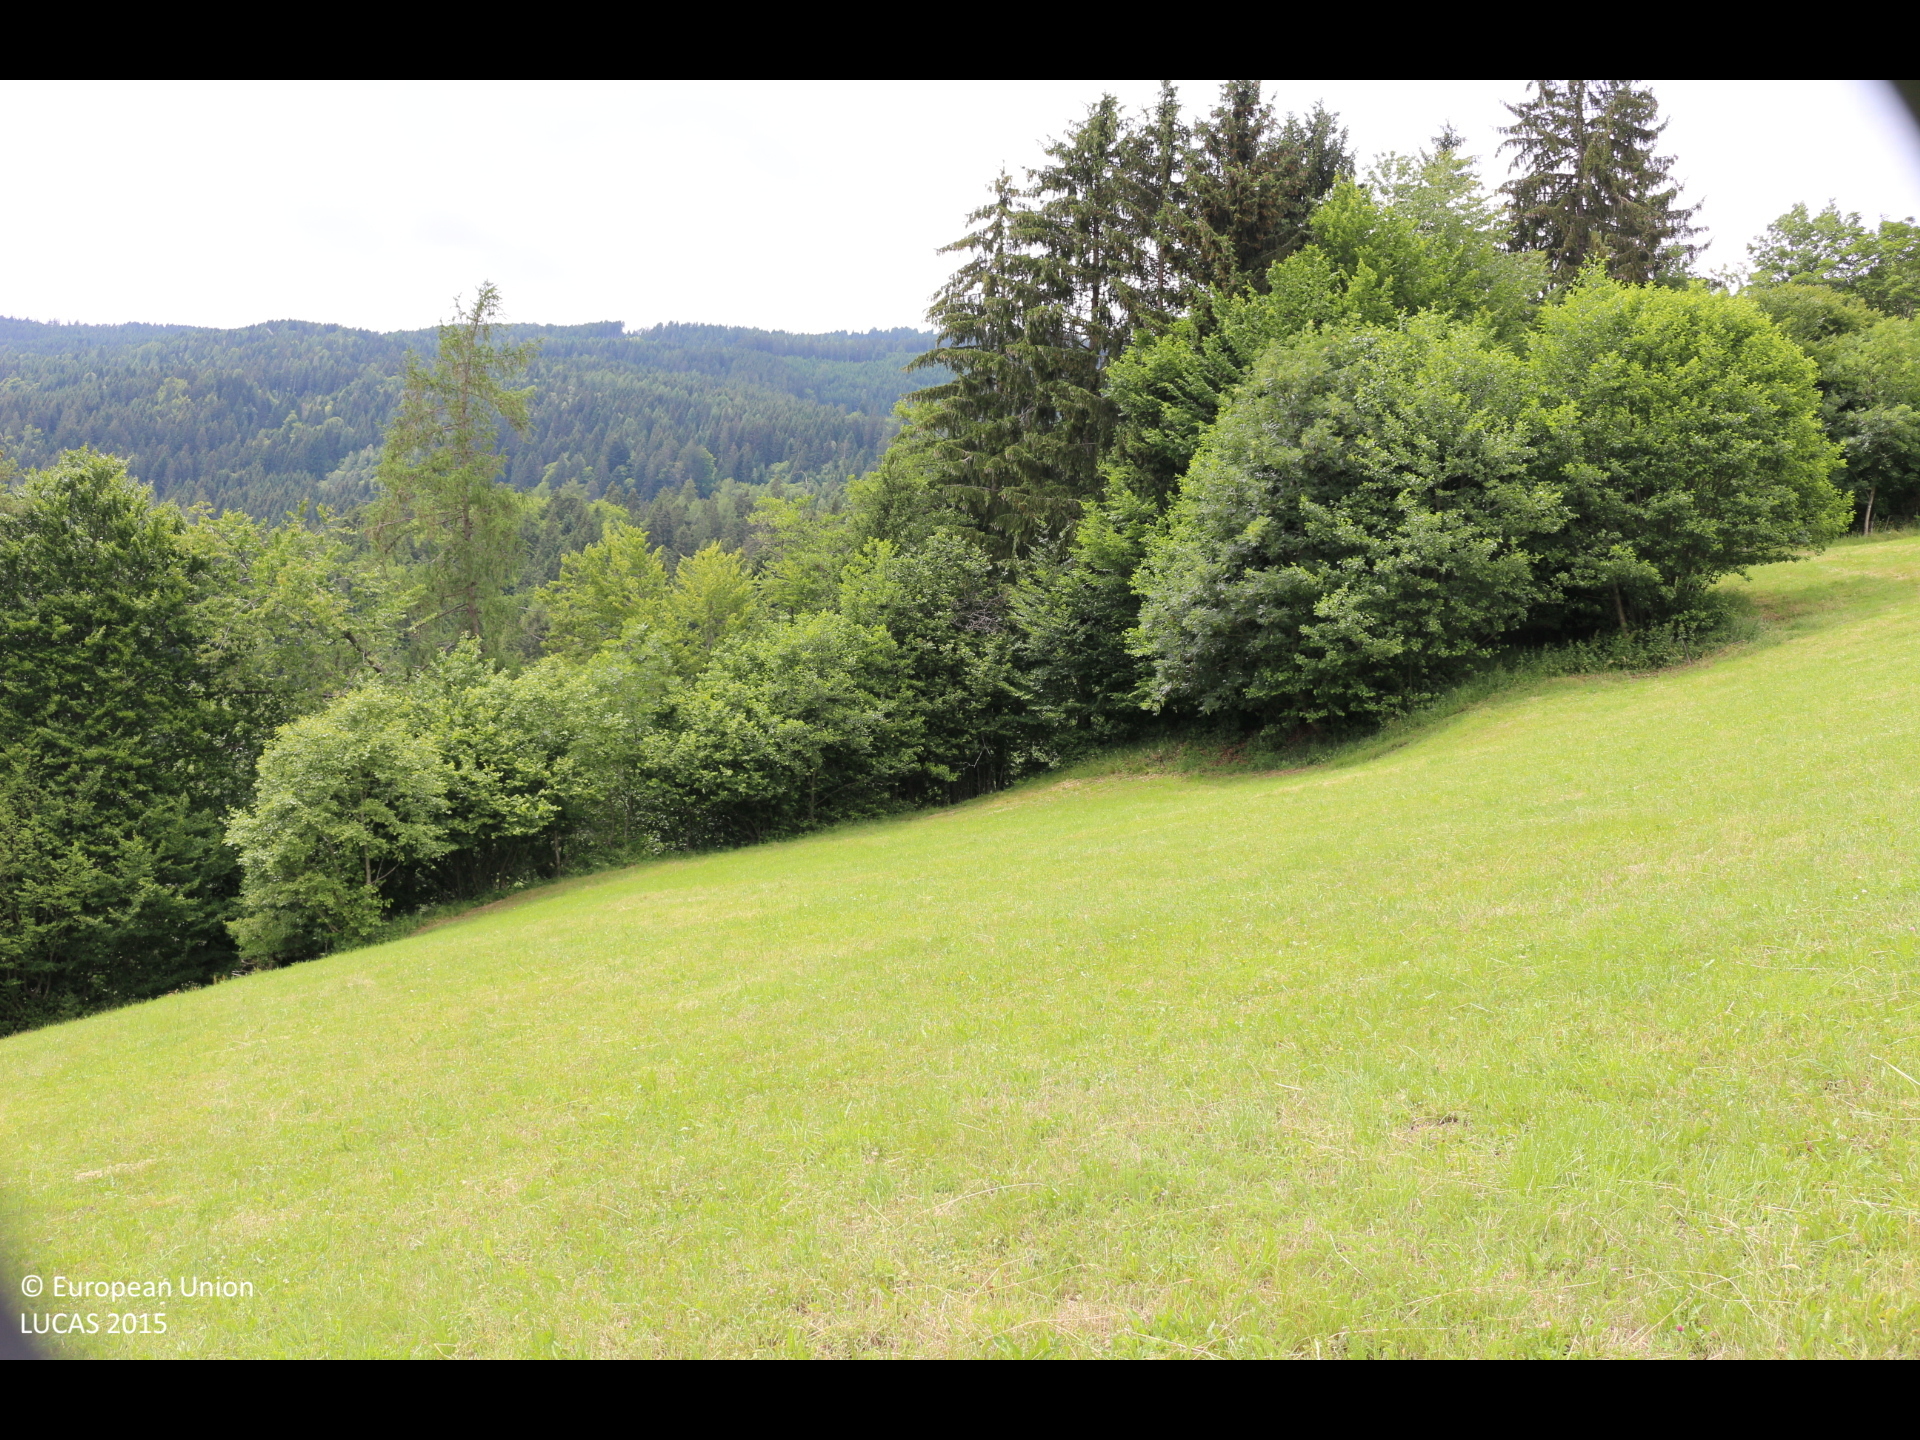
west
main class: Grassland
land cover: Grassland without tree/shrub cover
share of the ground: > 75 %
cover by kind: herbaceous plants 100 %
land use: Agriculture (excluding fallow land and kitchen gardens)
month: June
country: AT
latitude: 46.6927
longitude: 13.9596
